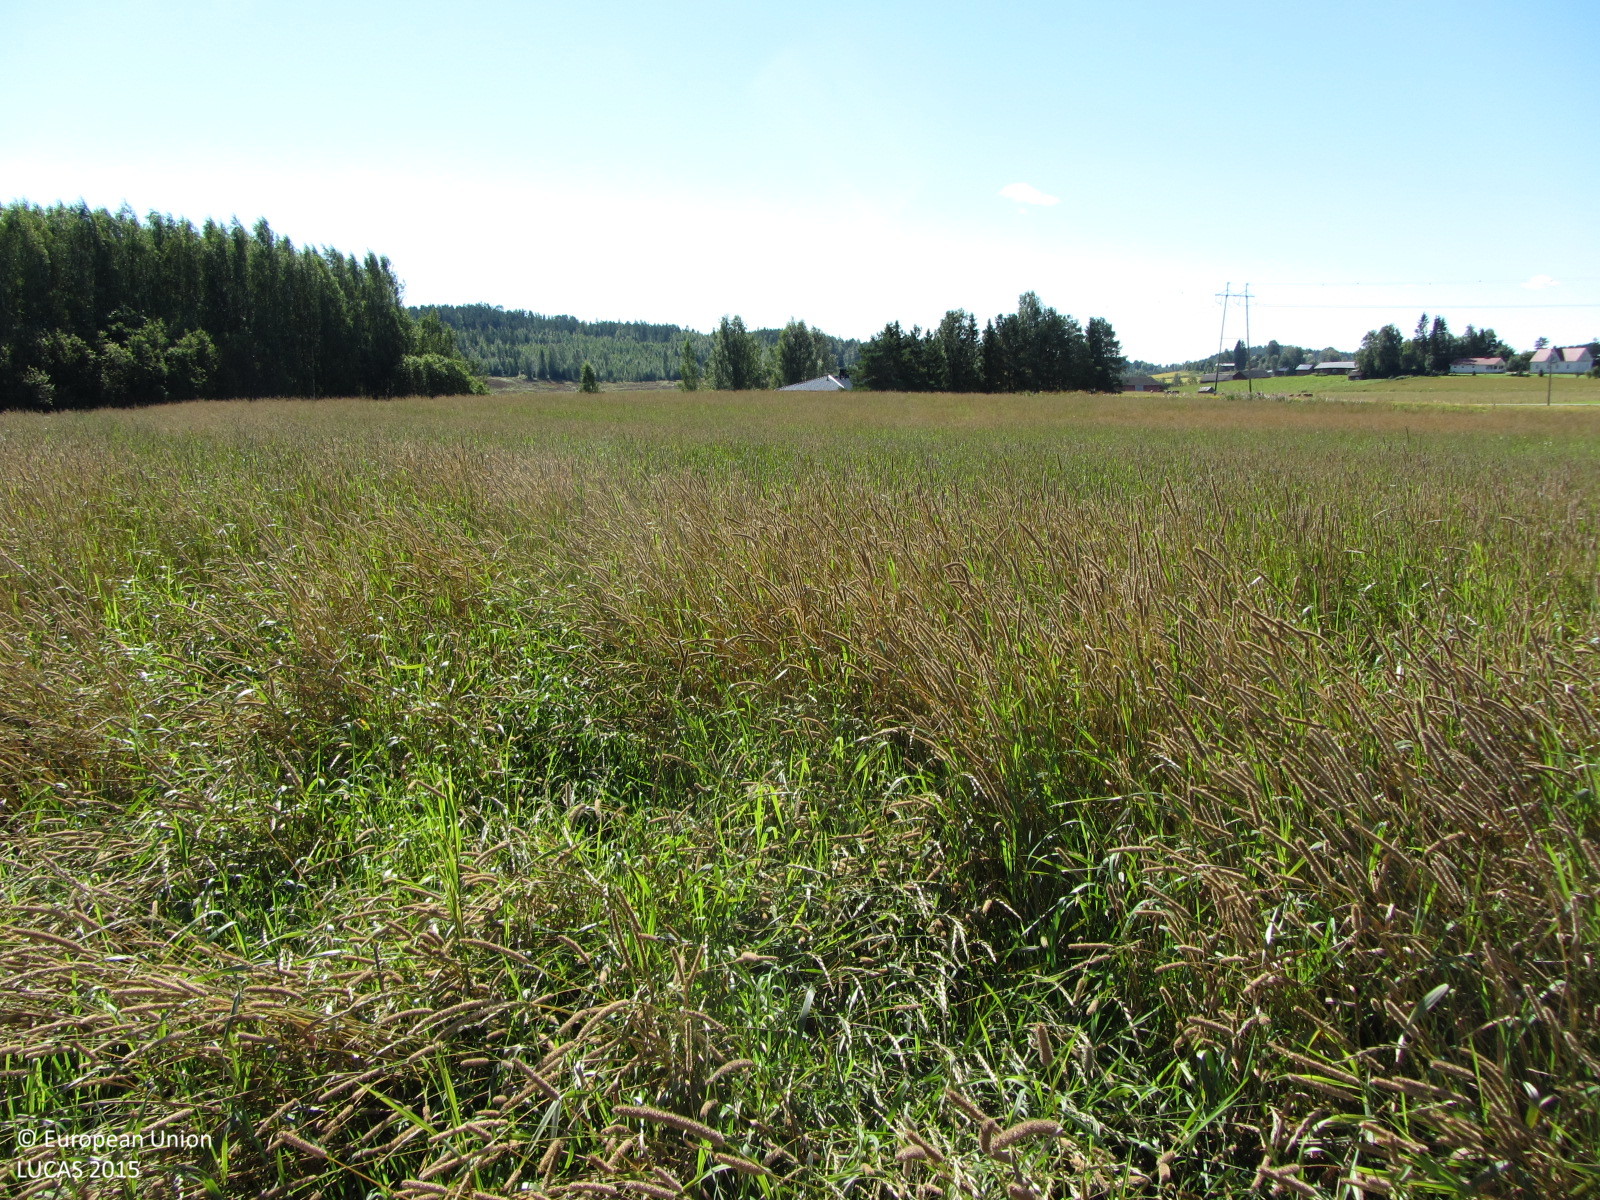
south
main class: Grassland
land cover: Spontaneously vegetated surfaces
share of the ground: > 75 %
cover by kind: herbaceous plants 100 %
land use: Fallow land
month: August
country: FI
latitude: 60.4524
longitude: 23.9663
